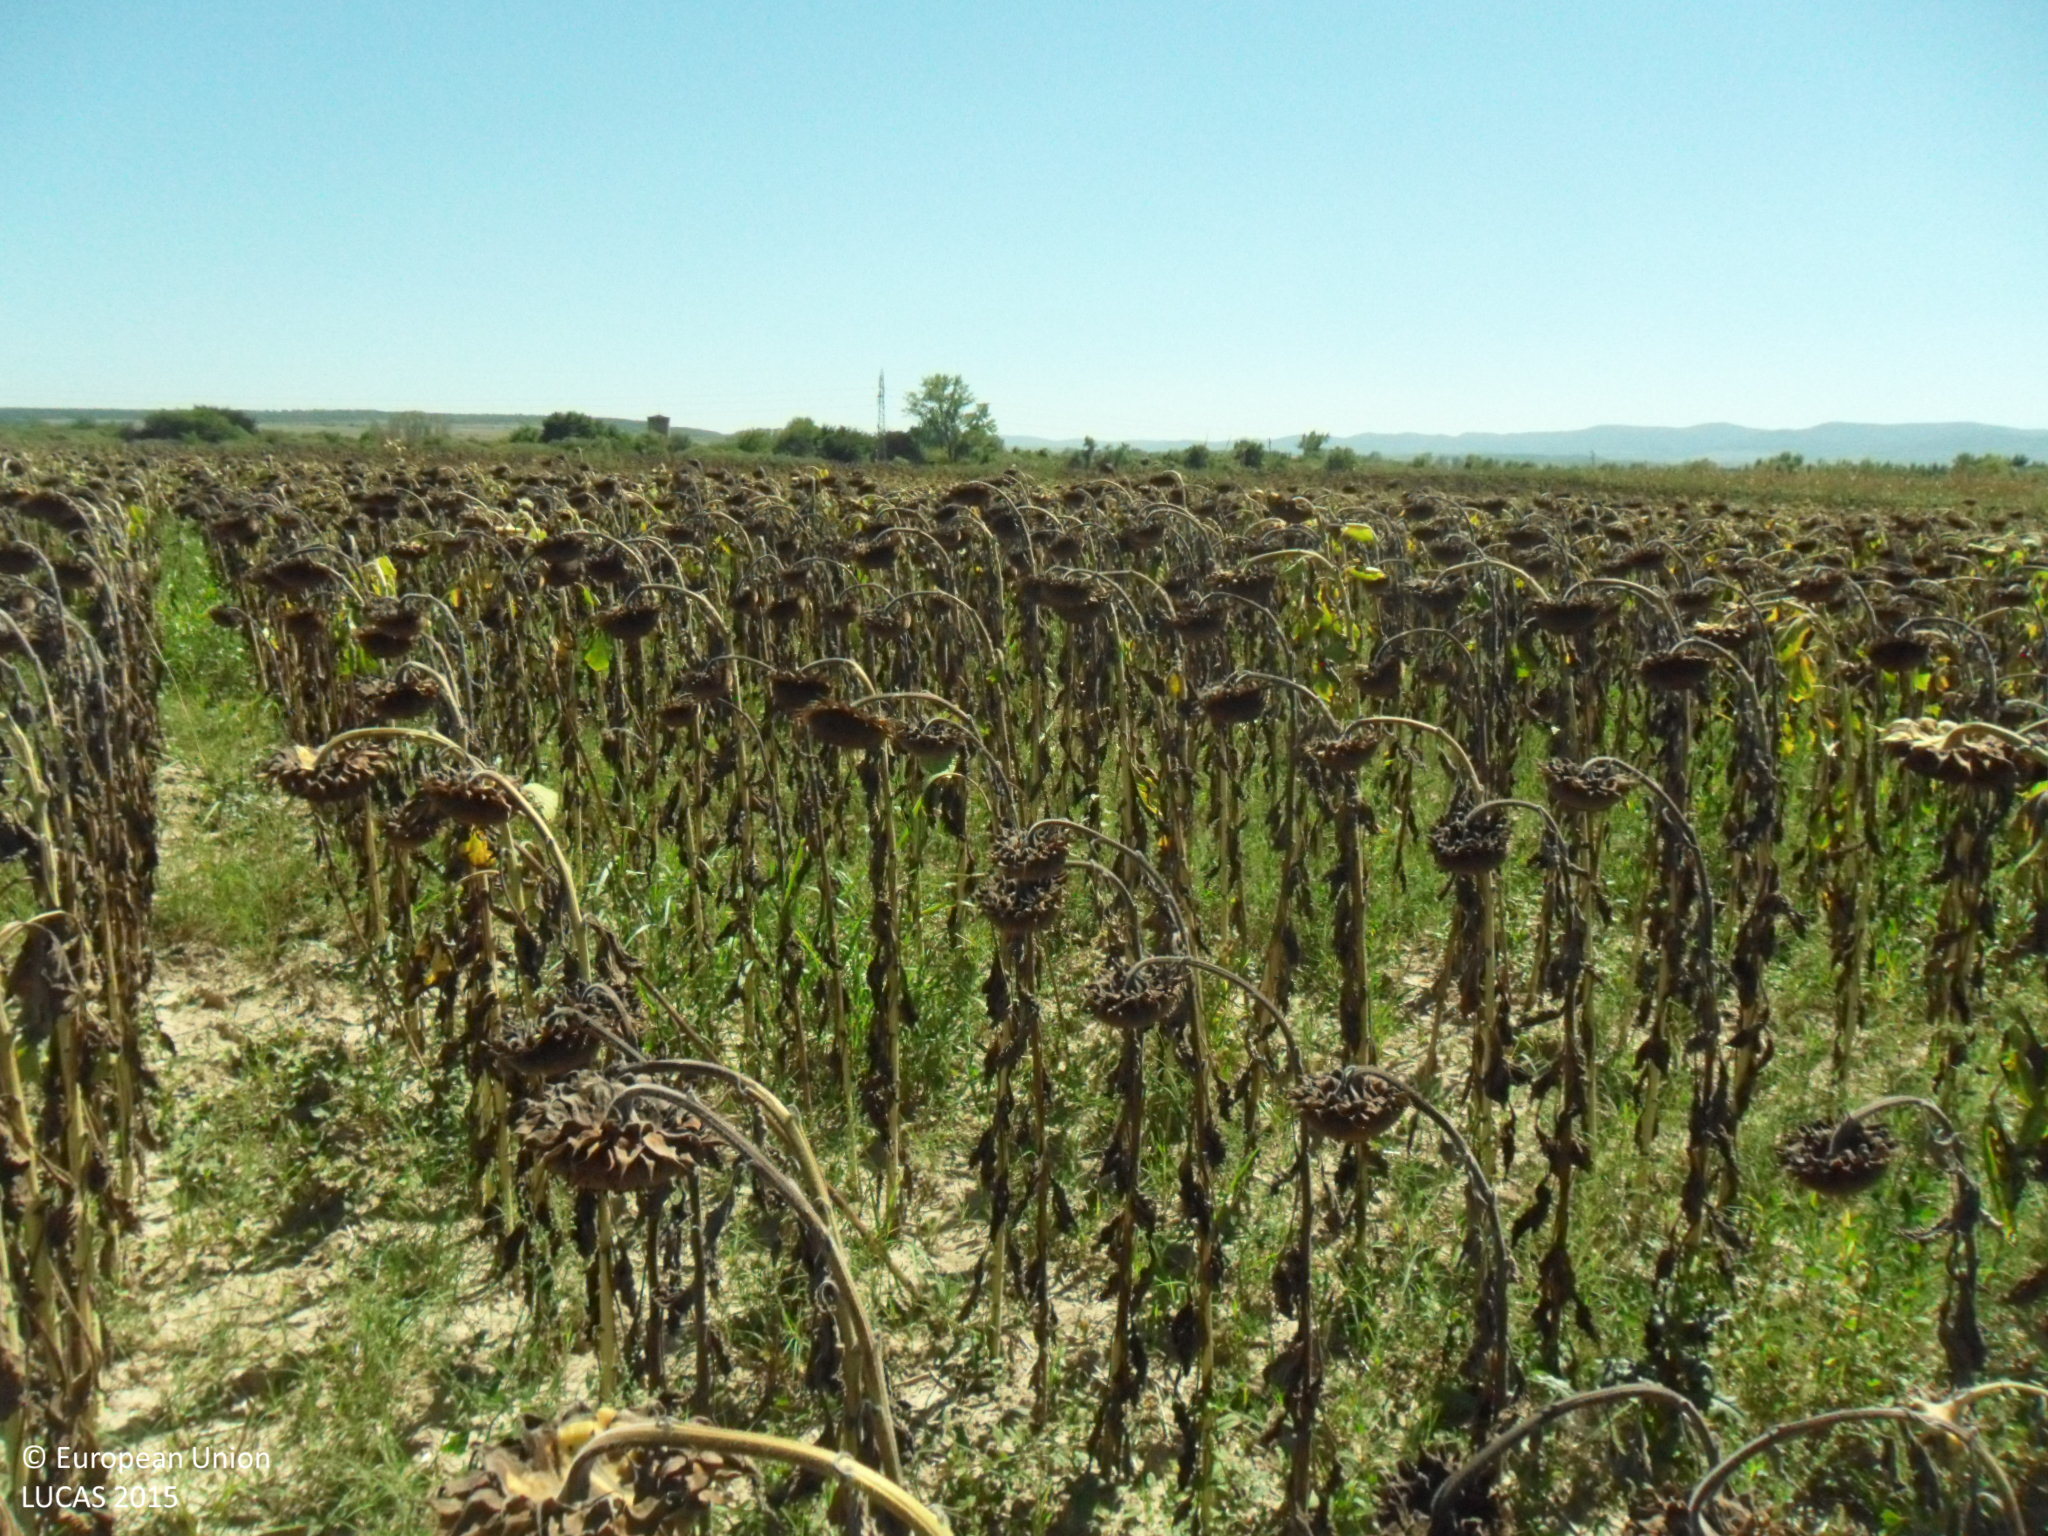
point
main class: Cropland
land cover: Sunflower
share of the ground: 50 - 75 %
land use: Agriculture (excluding fallow land and kitchen gardens)
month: September
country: BG
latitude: 43.1982
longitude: 26.8590
